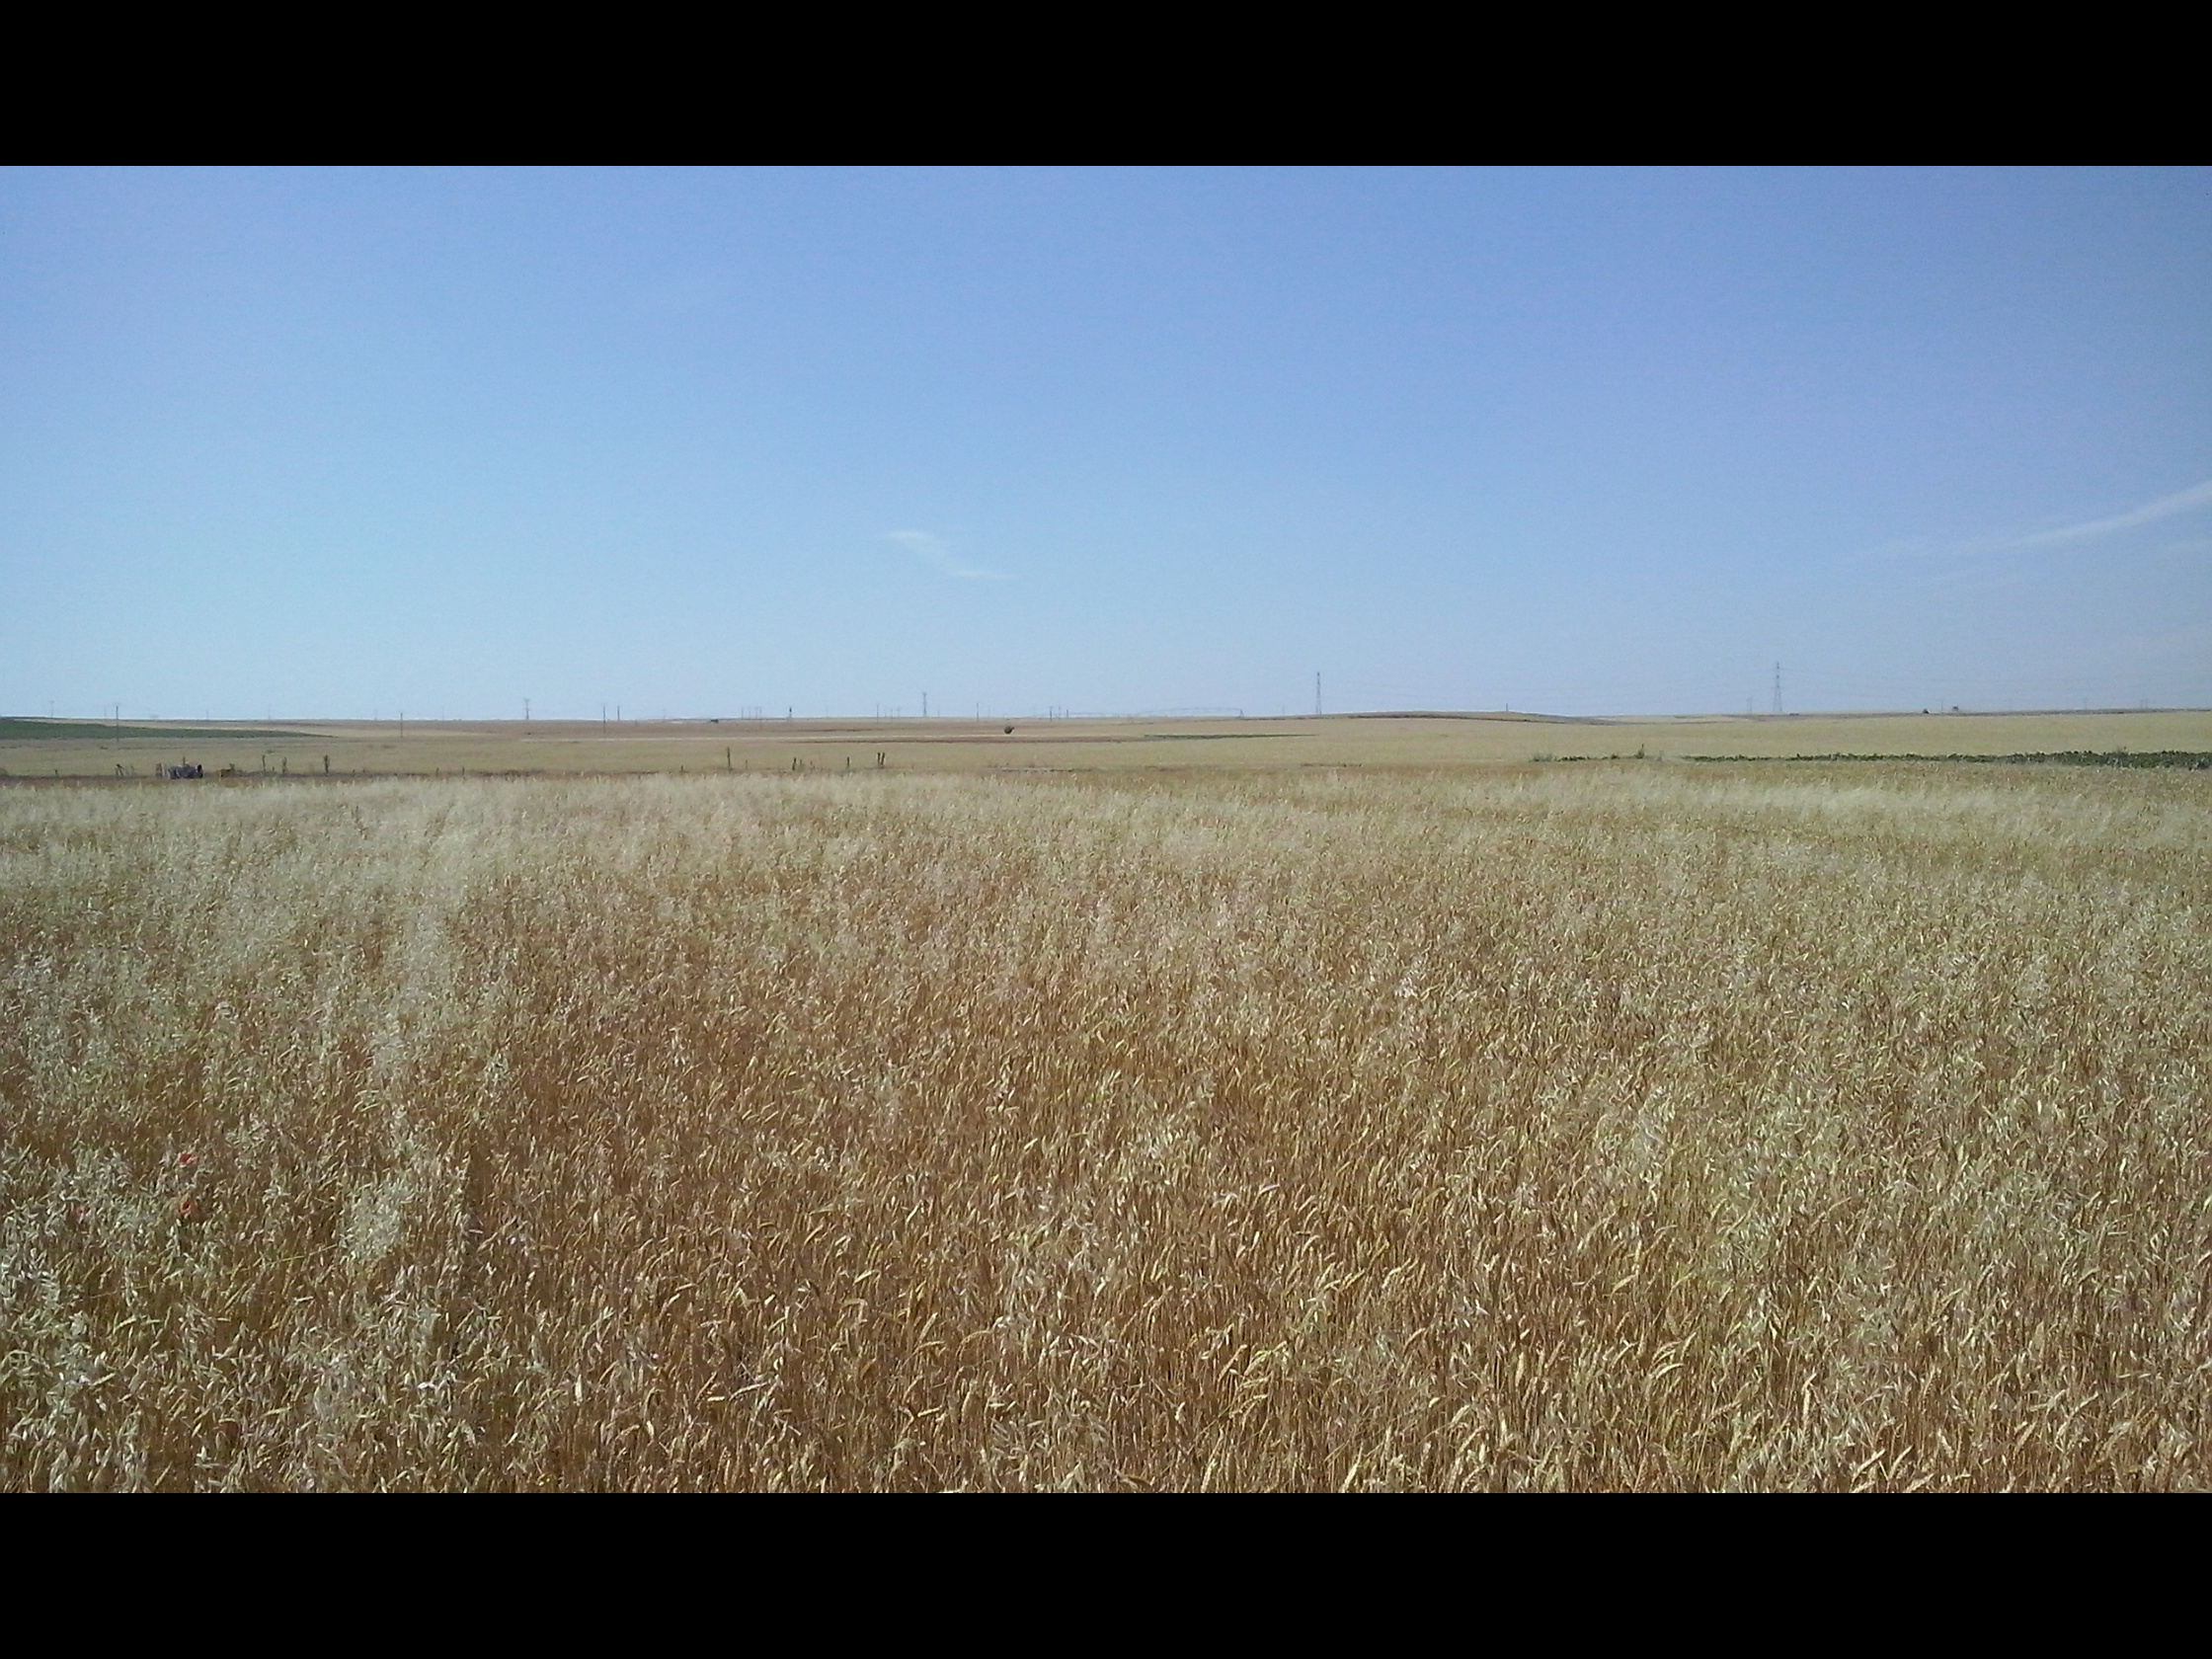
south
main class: Cropland
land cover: Common wheat
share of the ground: > 75 %
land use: Agriculture (excluding fallow land and kitchen gardens)
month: July
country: ES
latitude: 41.5516
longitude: -5.0967
